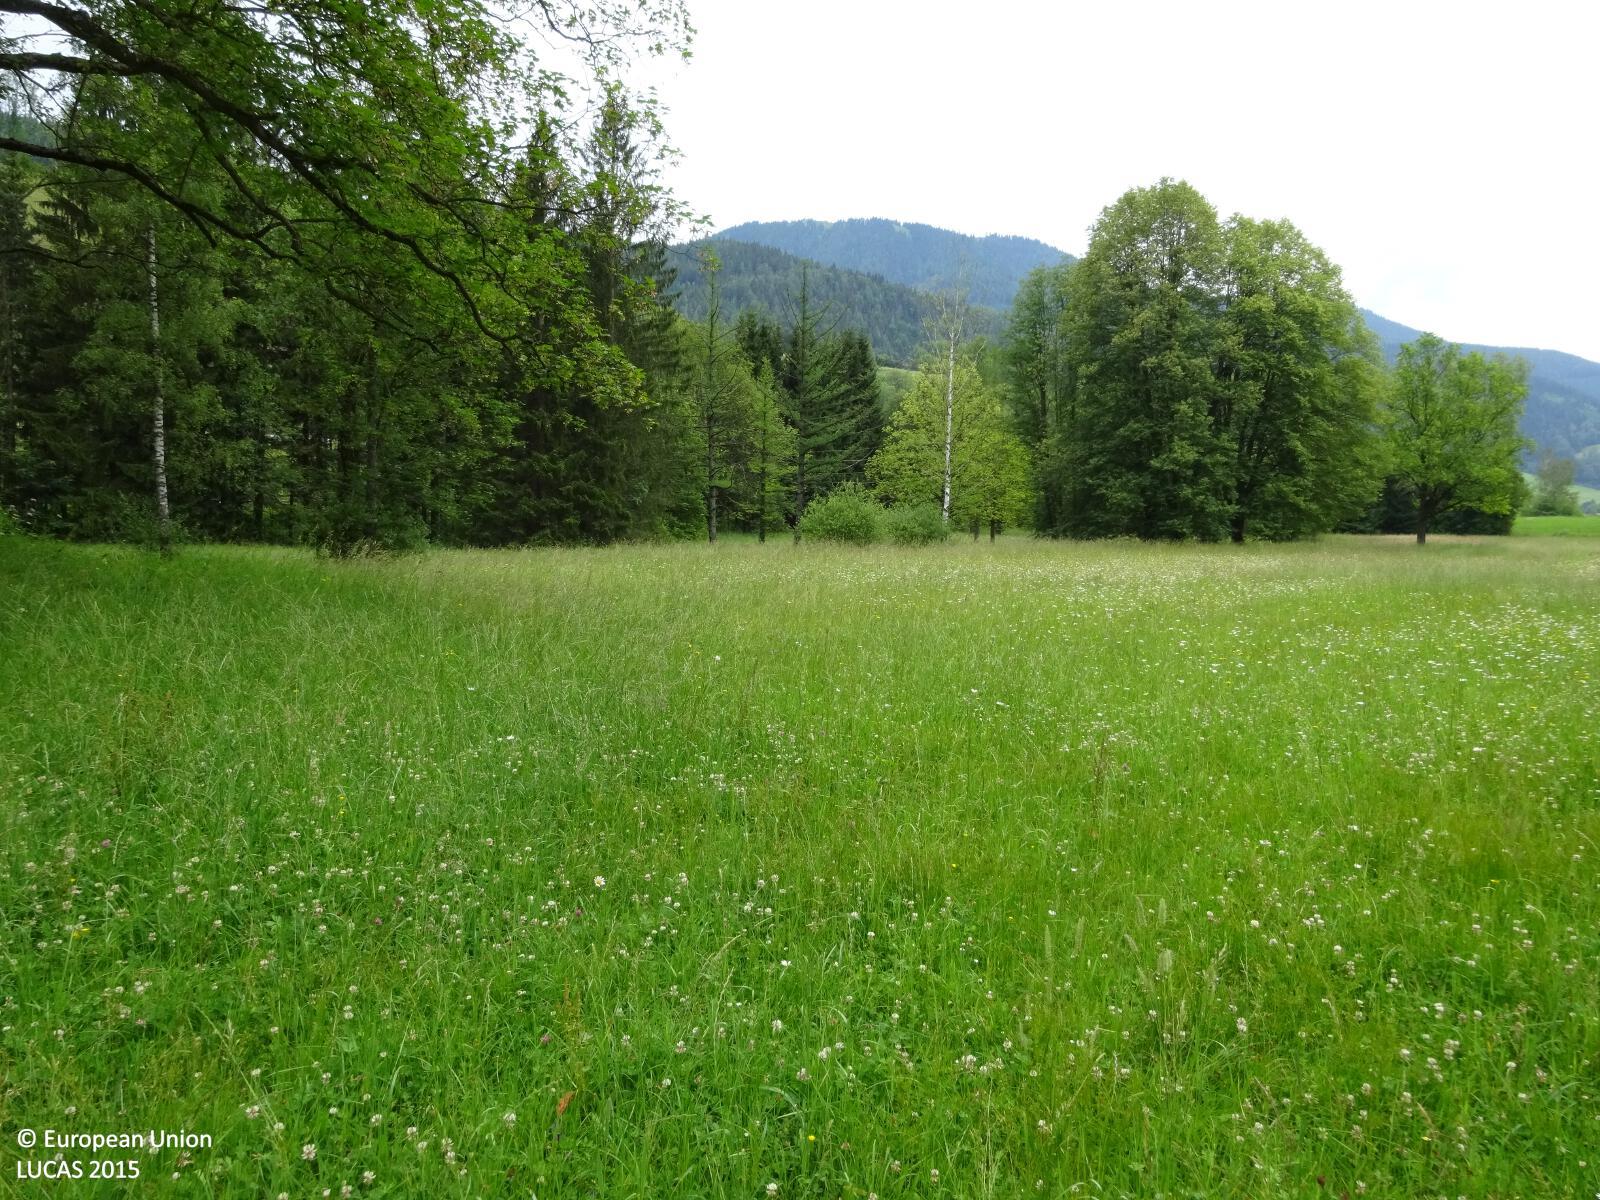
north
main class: Grassland
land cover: Grassland without tree/shrub cover
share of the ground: > 75 %
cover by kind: herbaceous plants 100 %
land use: Amenities, museums, leisure
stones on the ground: < 10 %
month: June
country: AT
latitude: 47.6052
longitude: 15.7348
